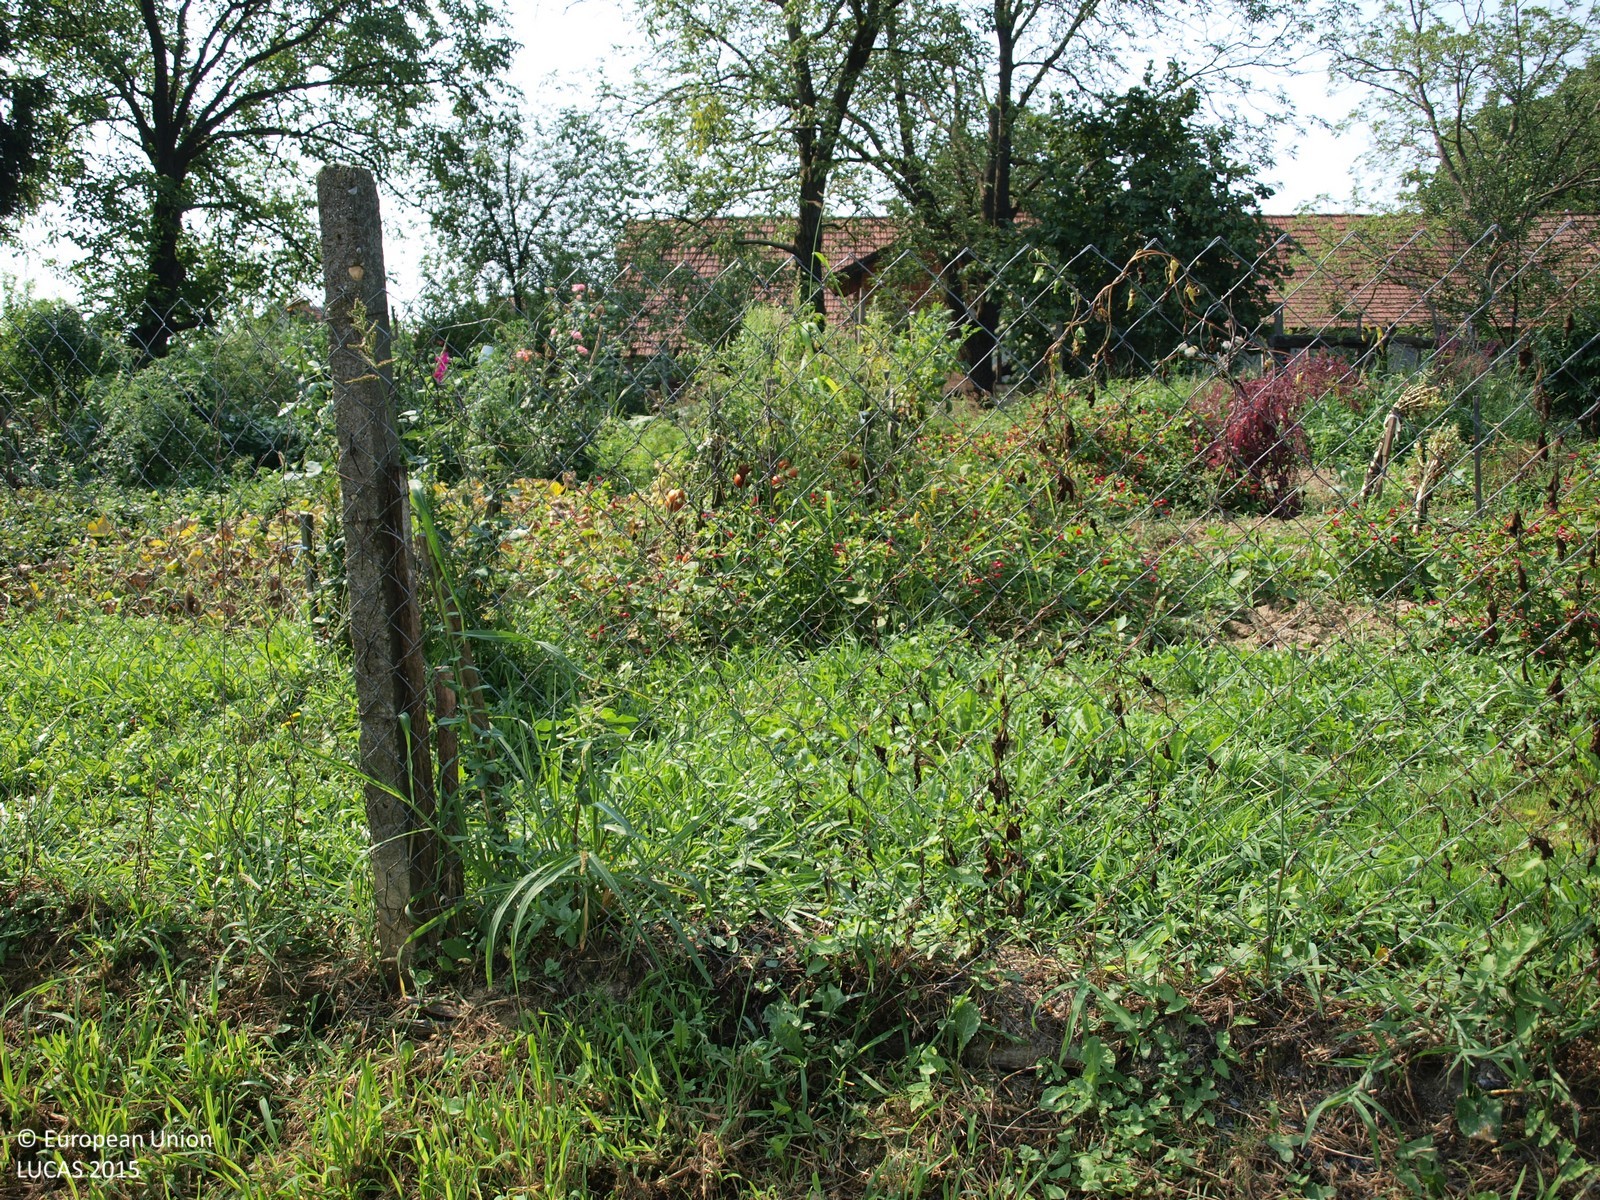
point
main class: Cropland
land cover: Tomatoes
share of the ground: > 75 %
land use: Kitchen garden
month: August
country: HR
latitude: 45.9046
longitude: 16.4315
